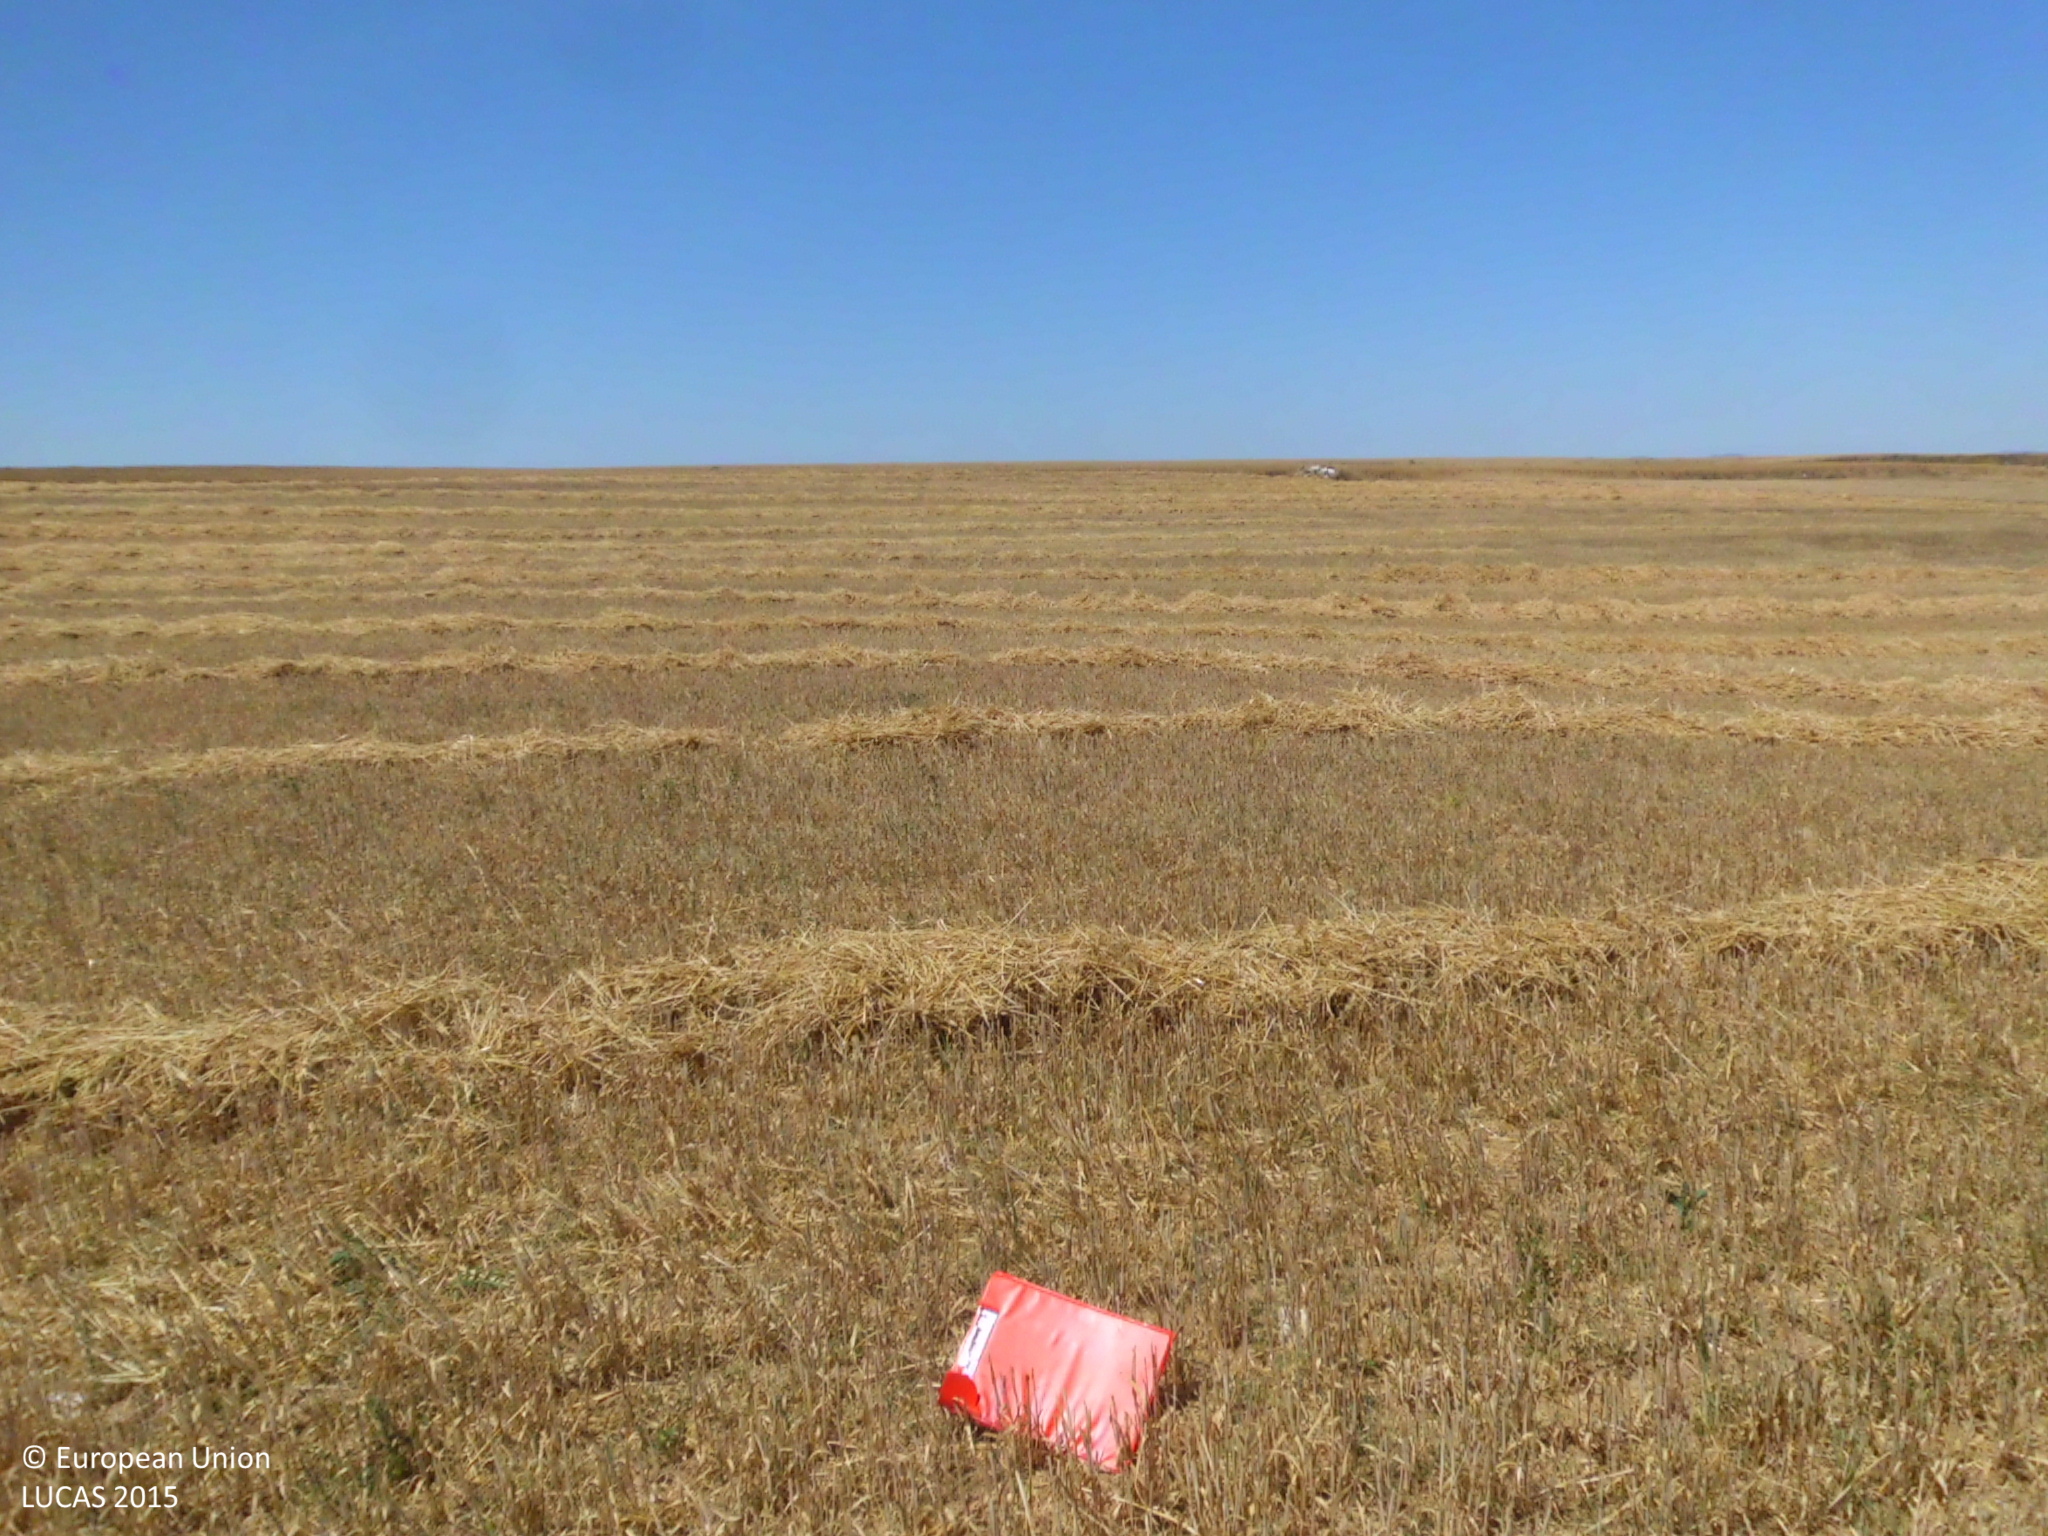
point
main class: Cropland
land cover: Barley
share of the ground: < 10 %
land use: Agriculture (excluding fallow land and kitchen gardens)
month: July
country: ES
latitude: 42.4911
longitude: -3.2566
